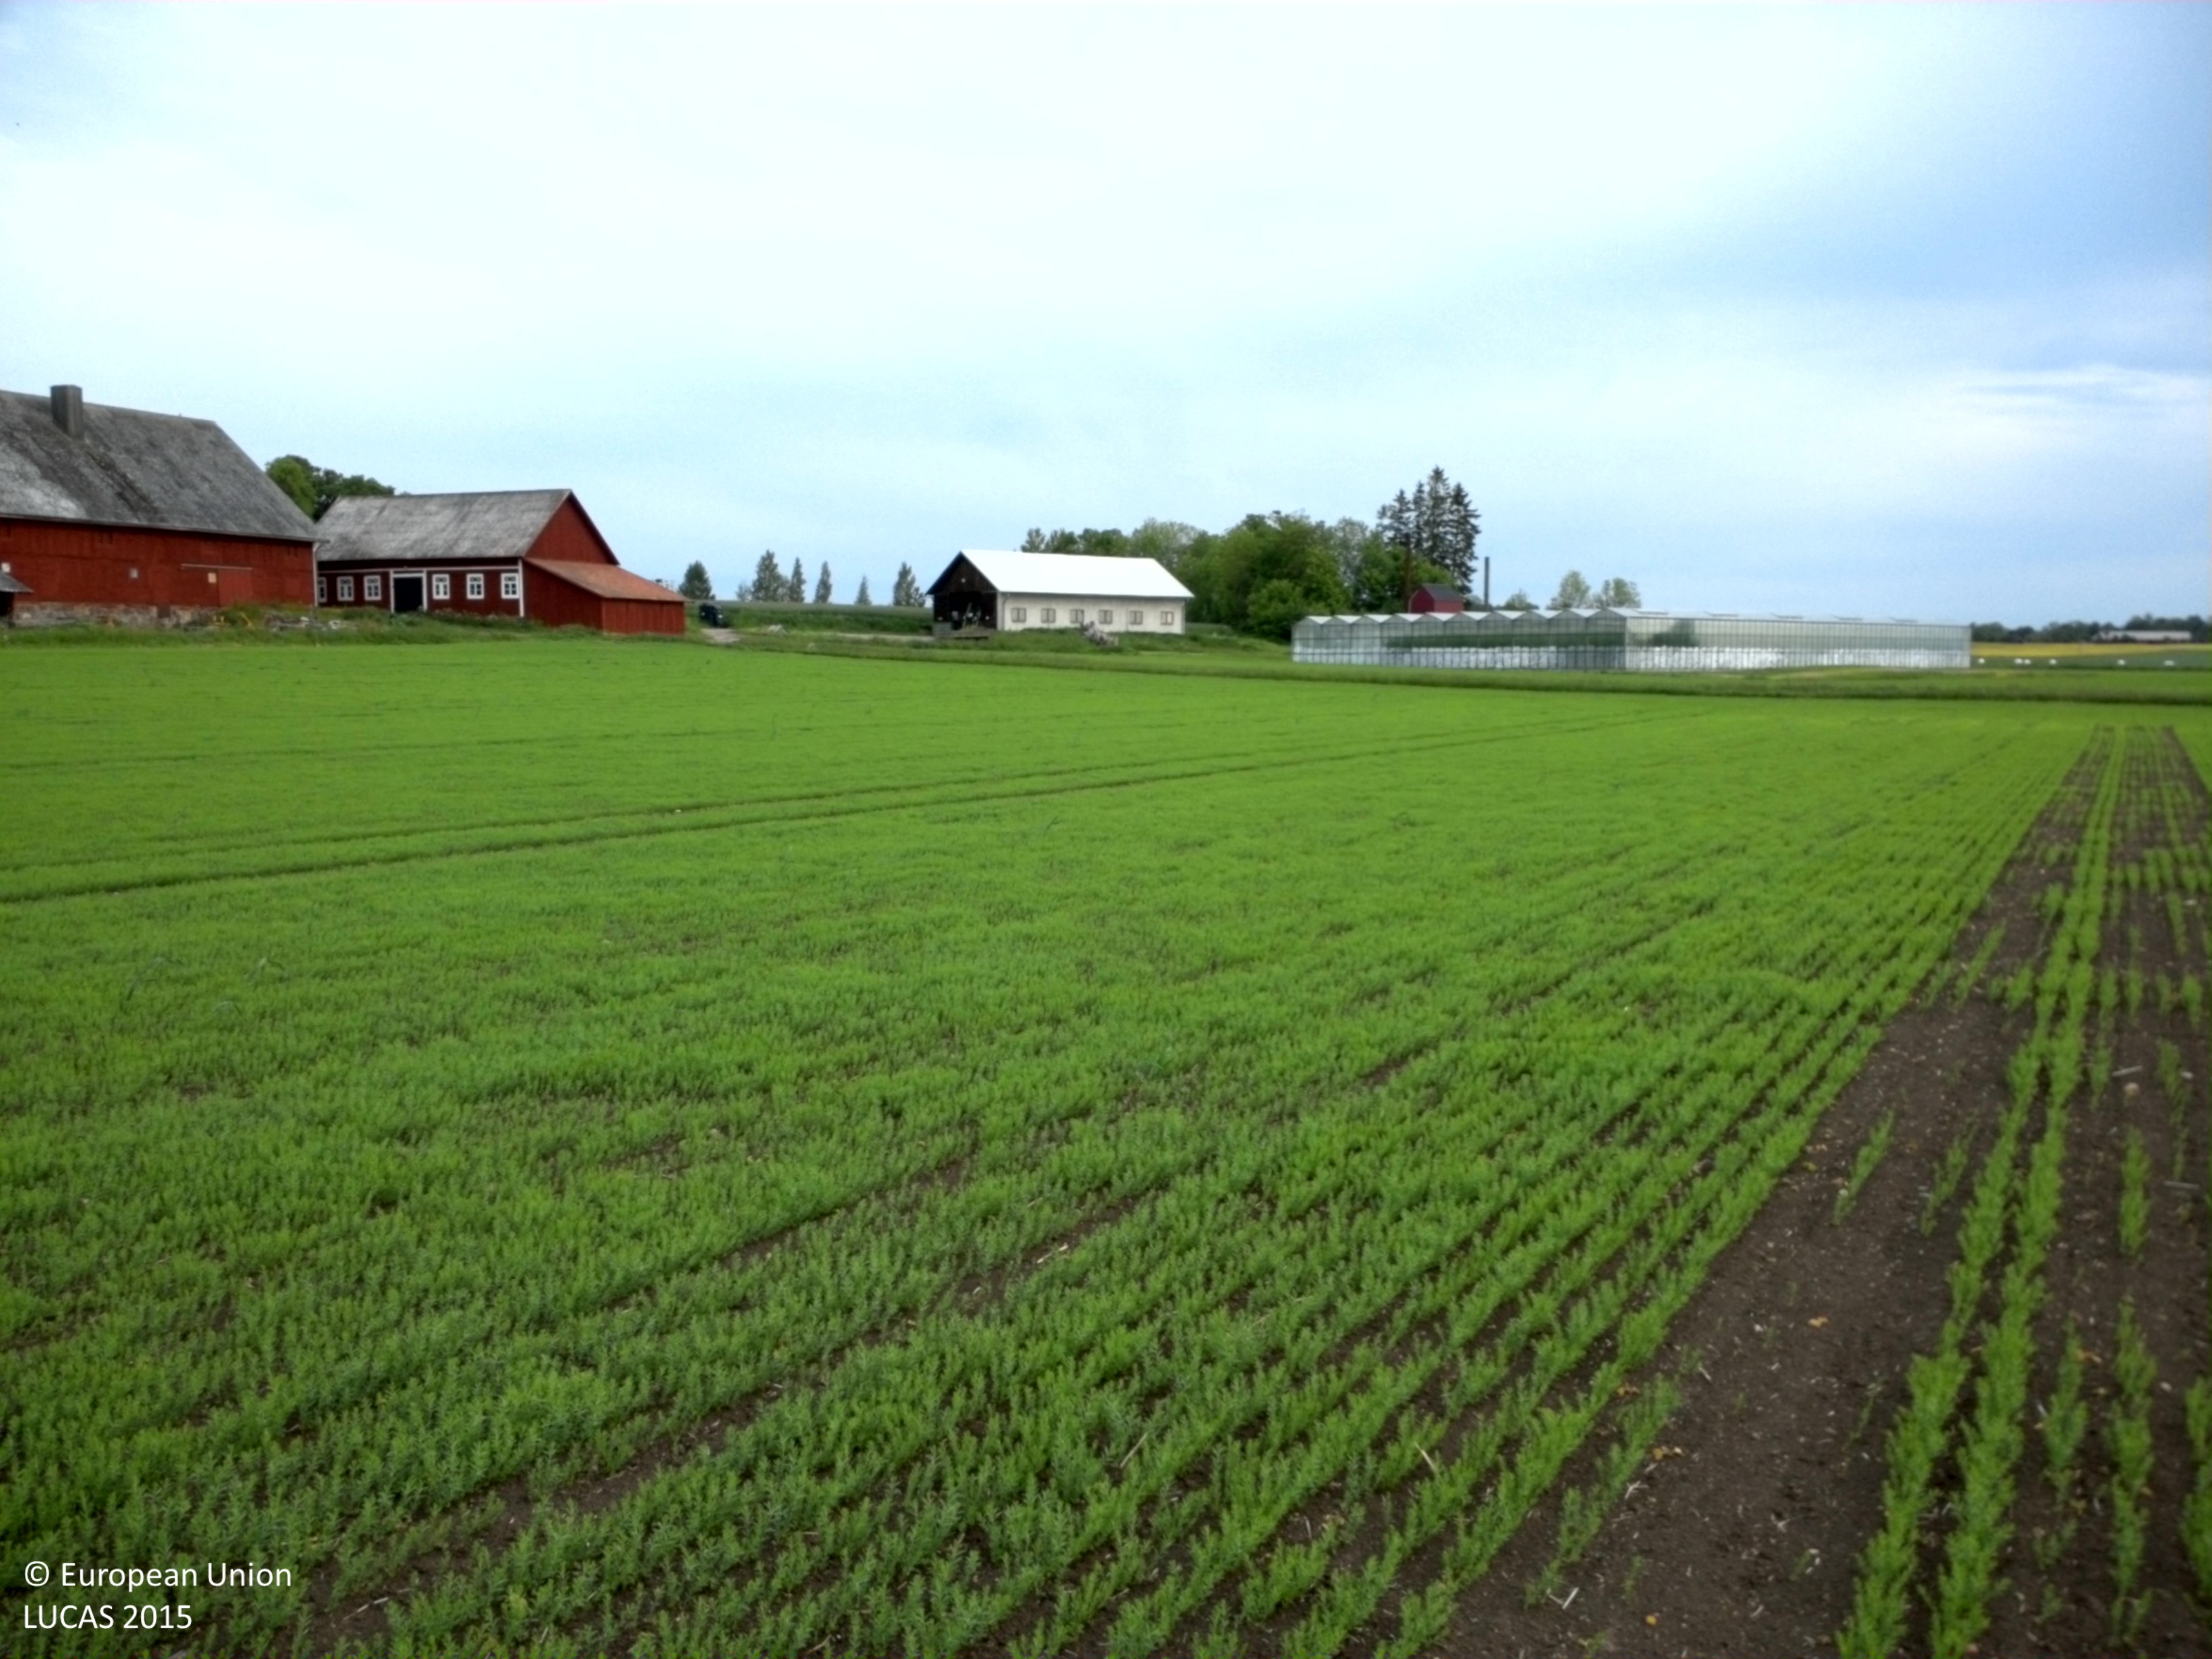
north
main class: Cropland
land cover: Other fibre and oleaginous crops
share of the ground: 10 - 25 %
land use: Agriculture (excluding fallow land and kitchen gardens)
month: June
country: SE
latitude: 58.4678
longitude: 15.4973
